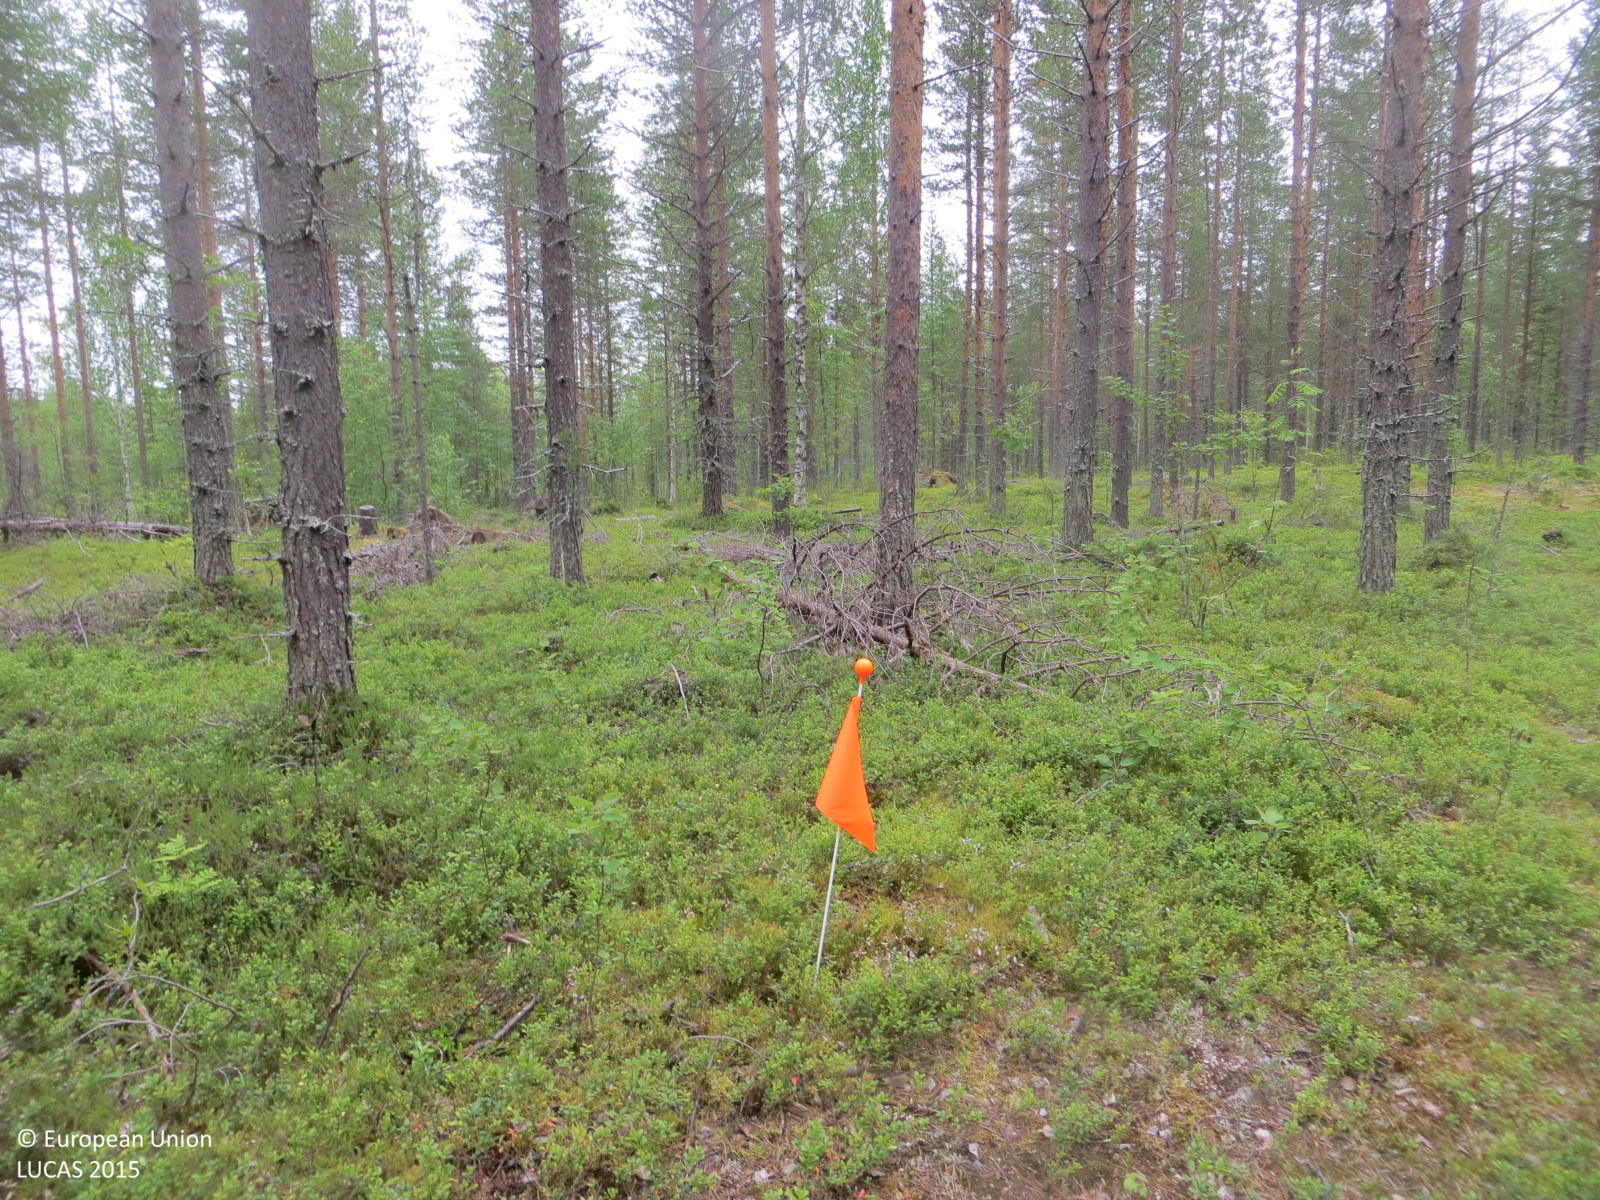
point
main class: Woodland
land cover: Pine dominated coniferous woodland
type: boreal forest
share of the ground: 50 - 75 %
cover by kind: coniferous forest trees 50 %, shrubs 40 %, broadleaved forest trees 10 %
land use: Forestry
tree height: > 5 m
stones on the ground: 10 - 25 %
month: July
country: FI
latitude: 66.3739
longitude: 24.1956
